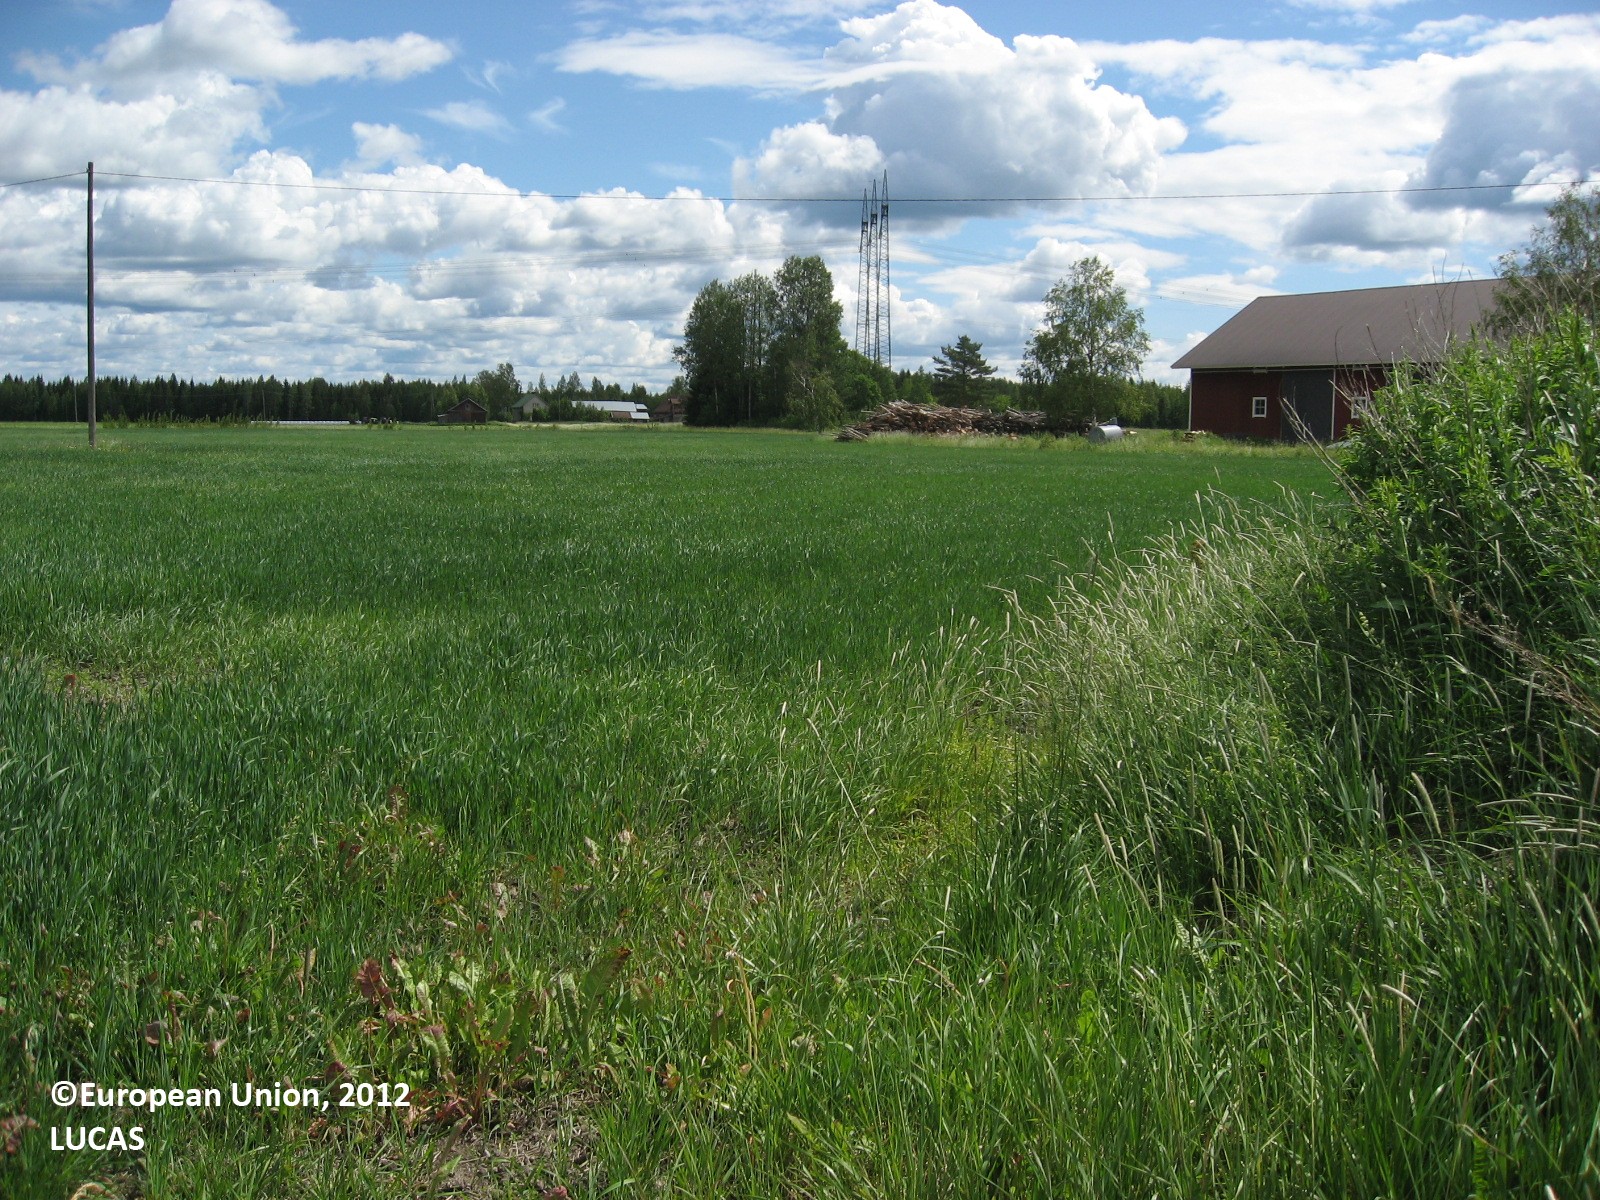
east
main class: Cropland
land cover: Oats
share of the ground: 50 - 75 %
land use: Agriculture (excluding fallow land and kitchen gardens)
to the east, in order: Oats; Electric lines; Oats; Grass margins; Ditches and canals; Grass margins; Other leguminous and mixtures for fodder
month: June
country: FI
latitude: 60.7275
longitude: 26.5273
